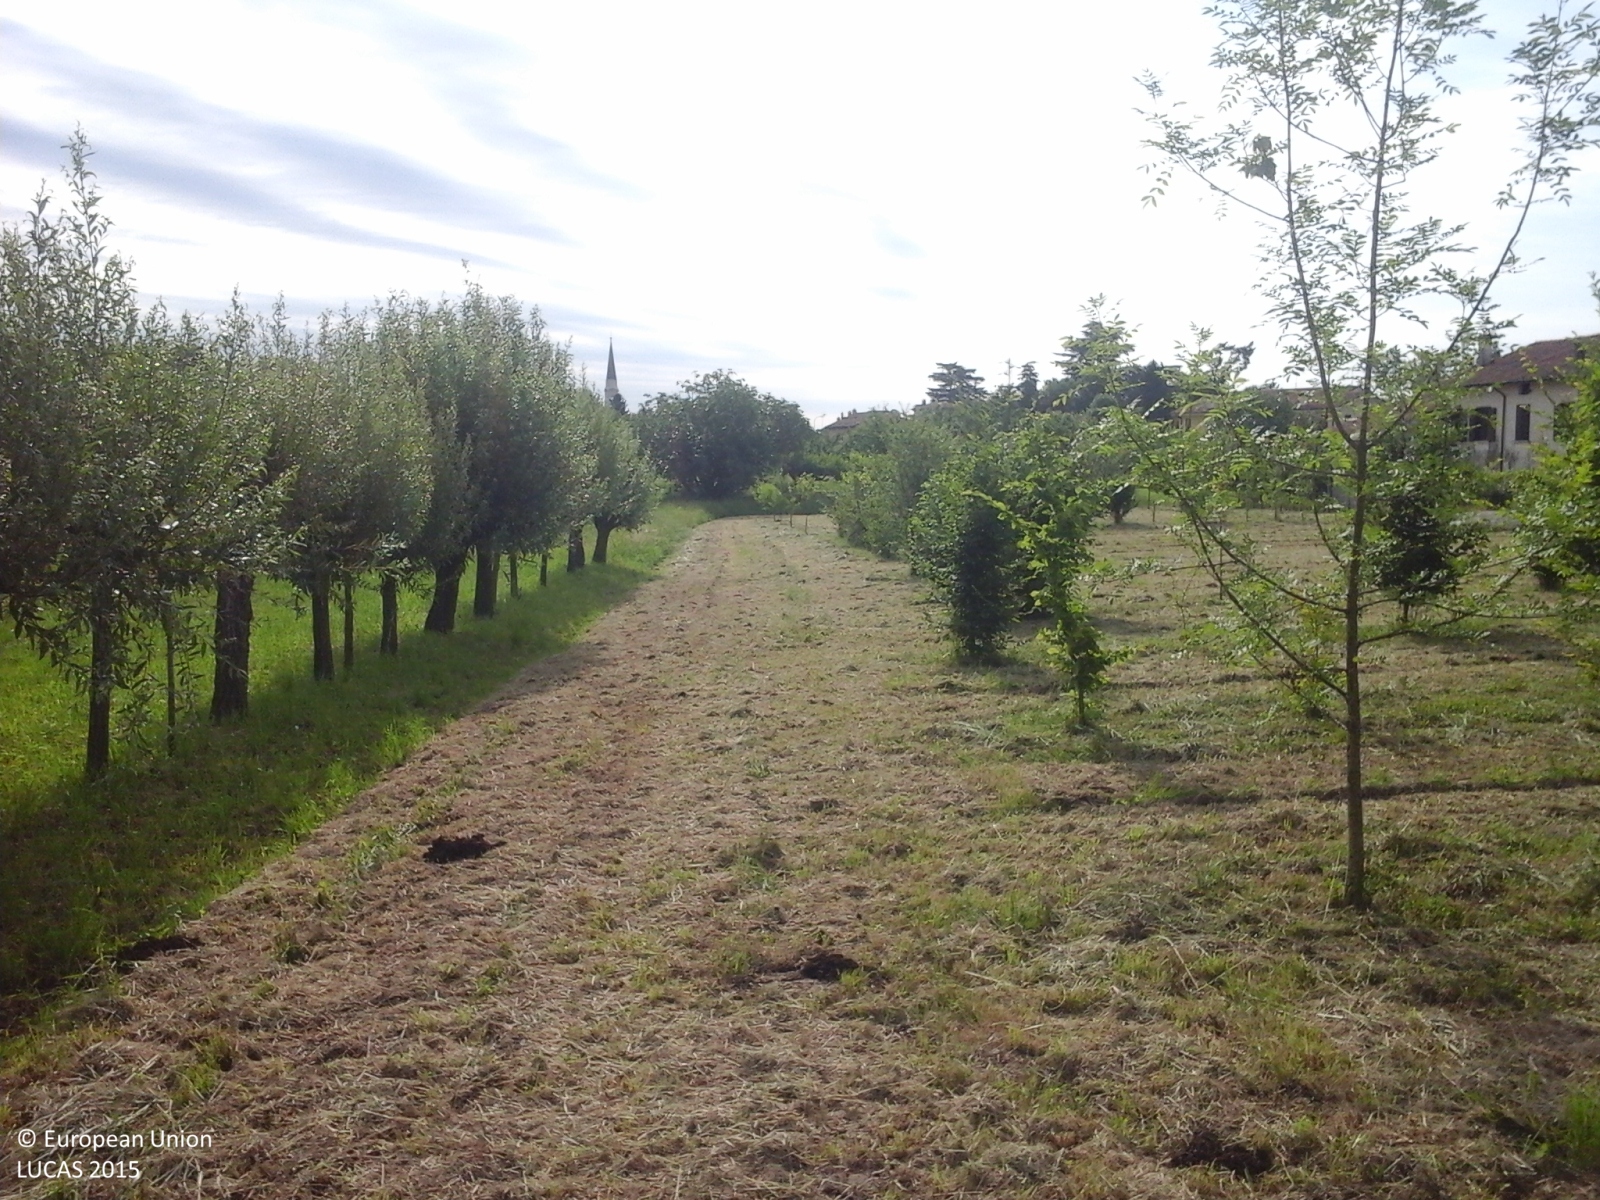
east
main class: Grassland
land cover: Grassland without tree/shrub cover
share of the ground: > 75 %
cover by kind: herbaceous plants 100 %
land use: Agriculture (excluding fallow land and kitchen gardens)
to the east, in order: Grassland without tree/shrub cover; Lines of trees; Grassland without tree/shrub cover; Other fresh vegetables; Grass margins; Vineyards; Tracks; Grassland without tree/shrub cover; Inland fresh running water; Managed hedges; Grassland without tree/shrub cover; Maize
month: June
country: IT
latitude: 45.7093
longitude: 11.5519
